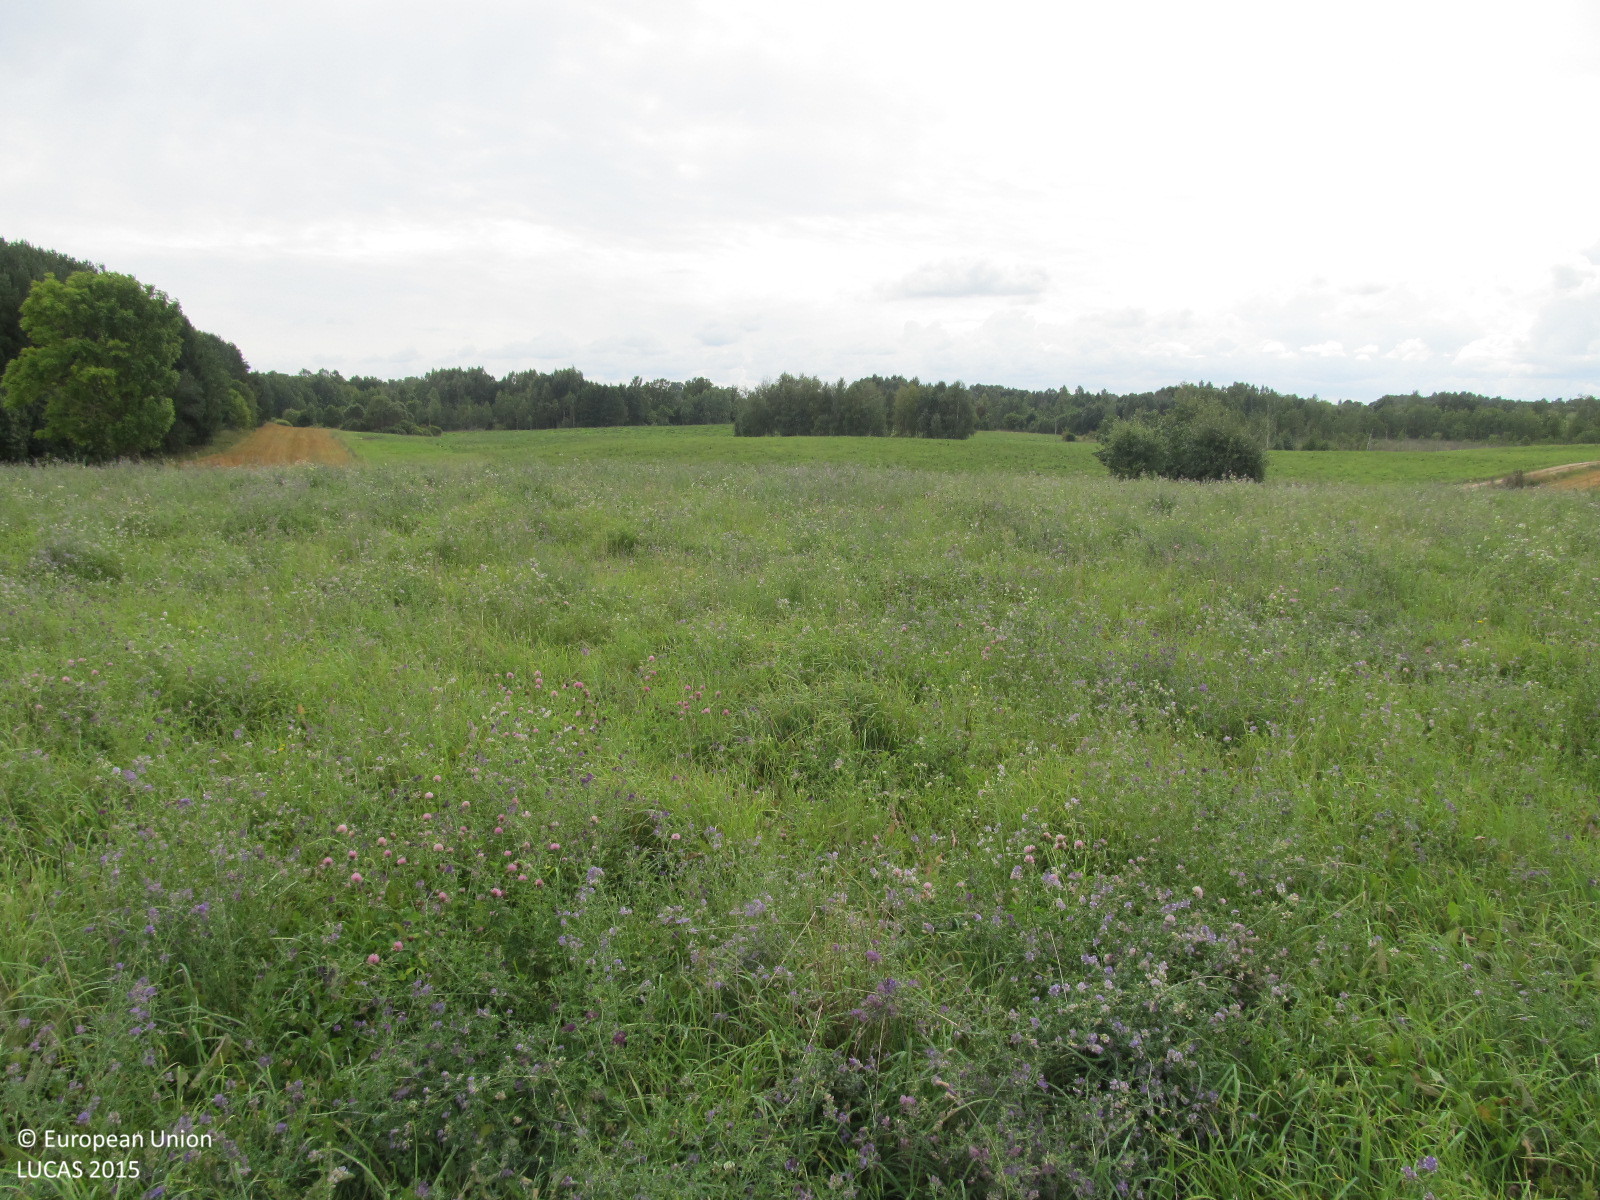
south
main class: Grassland
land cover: Grassland without tree/shrub cover
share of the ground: > 75 %
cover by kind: herbaceous plants 100 %
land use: Agriculture (excluding fallow land and kitchen gardens)
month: September
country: LT
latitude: 55.7043
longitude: 22.6502
